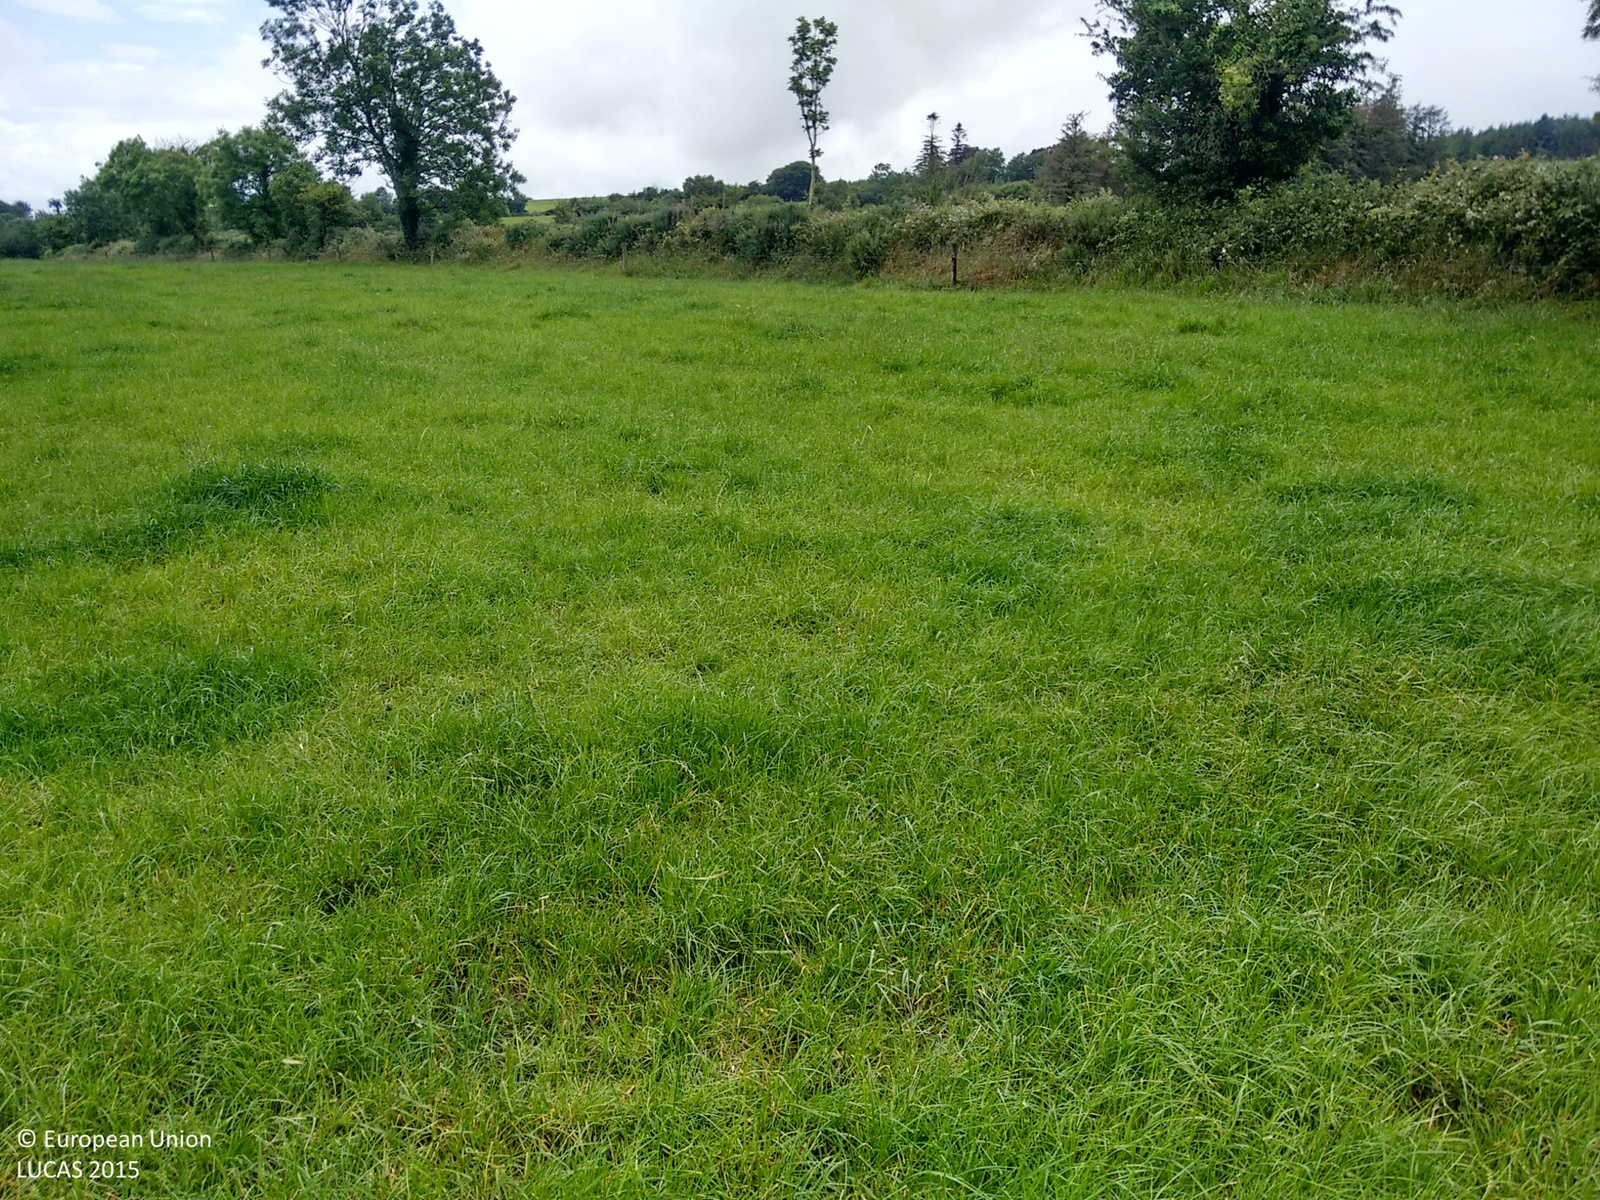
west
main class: Grassland
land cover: Grassland without tree/shrub cover
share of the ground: > 75 %
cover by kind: herbaceous plants 90 %, shrubs 5 %, unconsolidated bare surface 5 %
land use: Agriculture (excluding fallow land and kitchen gardens)
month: July
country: IE
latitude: 52.1910
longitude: -8.1902
